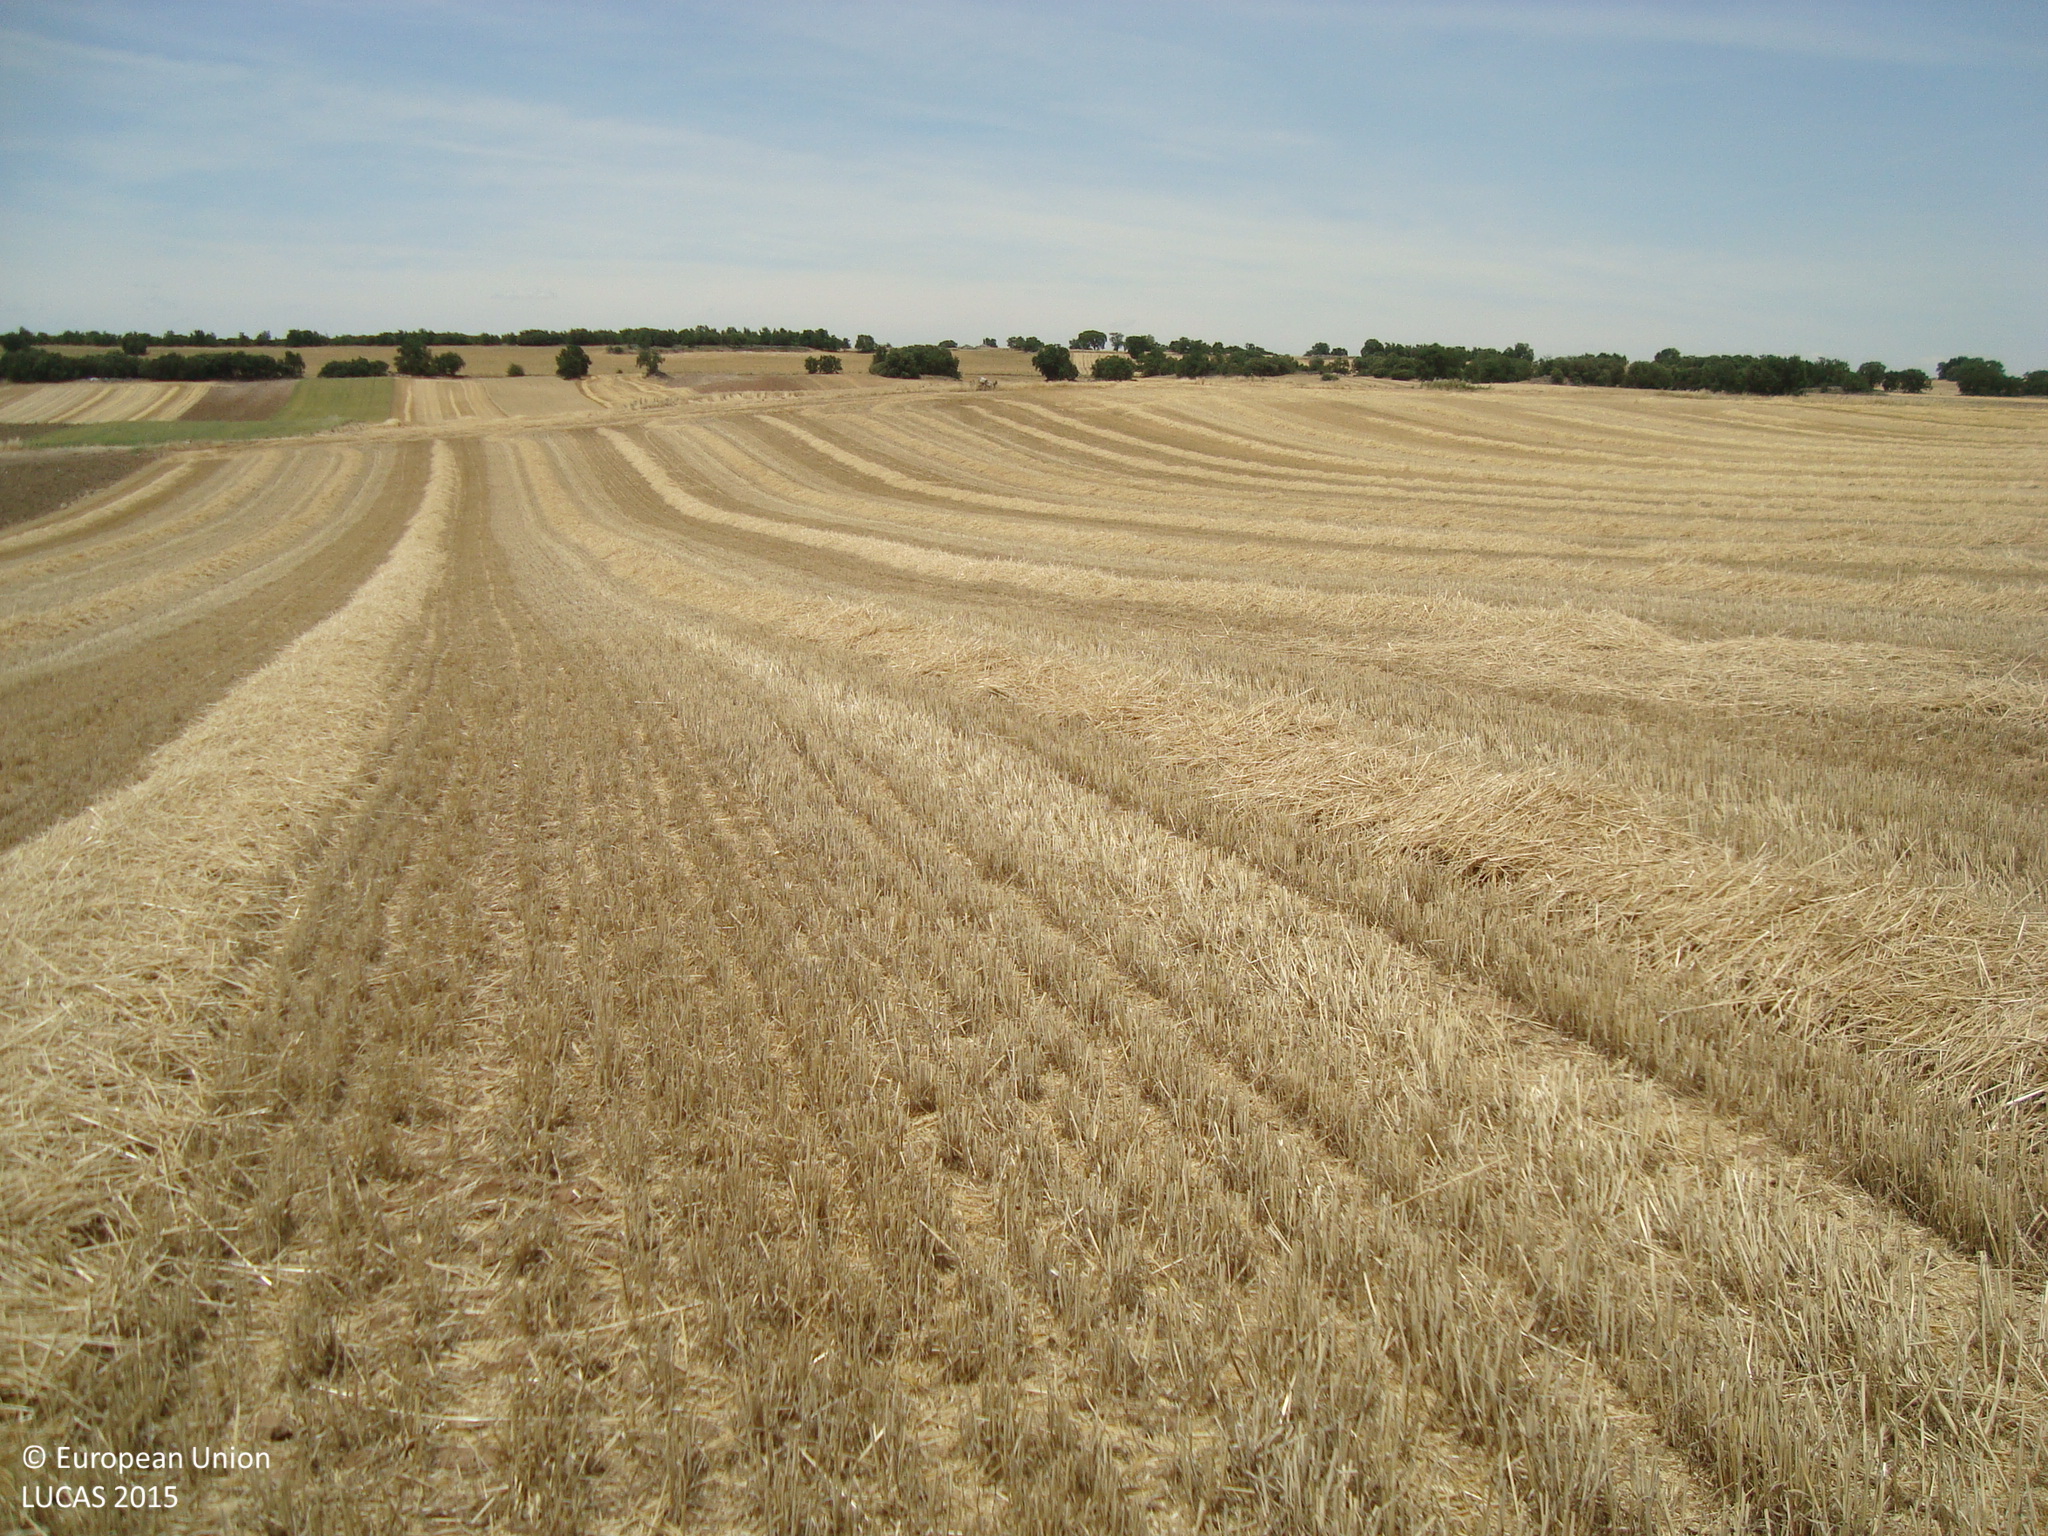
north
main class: Cropland
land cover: Common wheat
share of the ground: < 10 %
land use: Agriculture (excluding fallow land and kitchen gardens)
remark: Harvested field
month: July
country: ES
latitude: 41.7898
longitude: -4.1033
